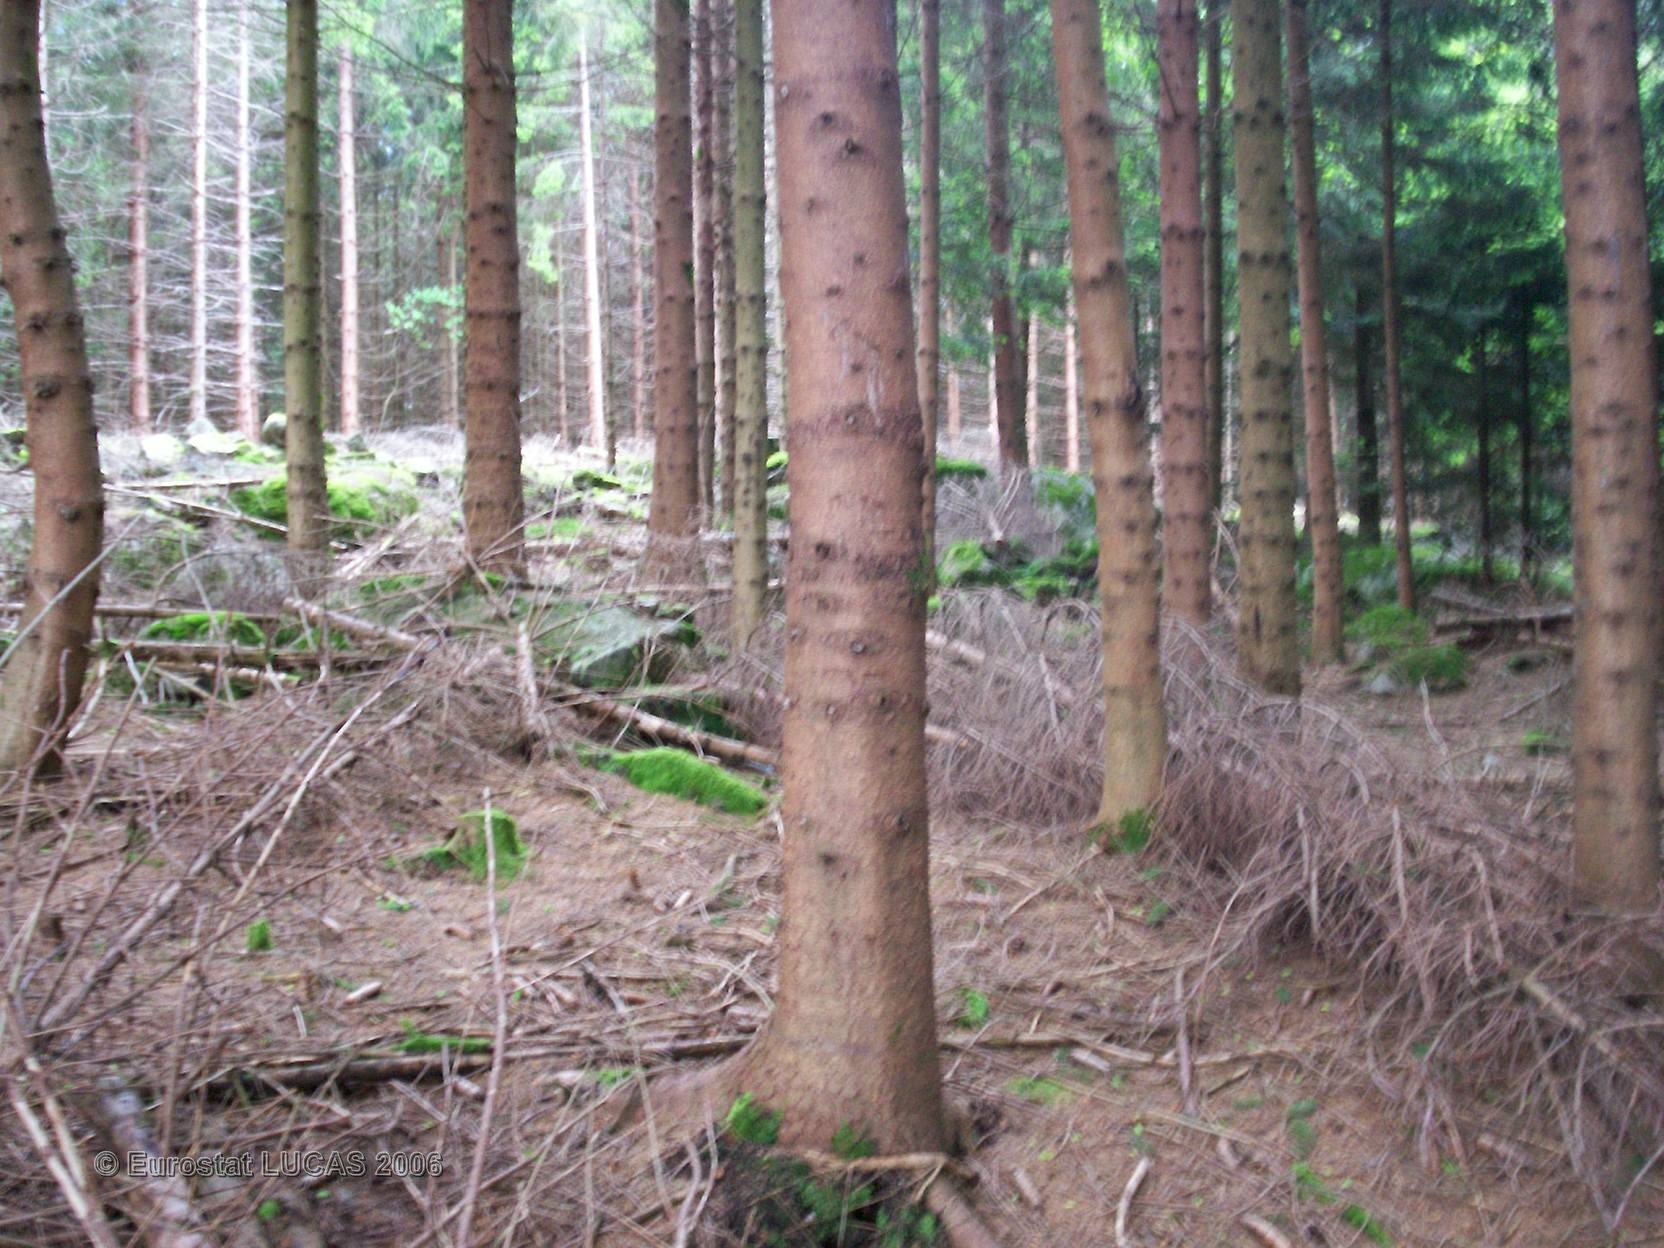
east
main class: Woodland
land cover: Coniferous forest
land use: Forestry
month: June
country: FR
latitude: 48.1041
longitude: 6.7645
